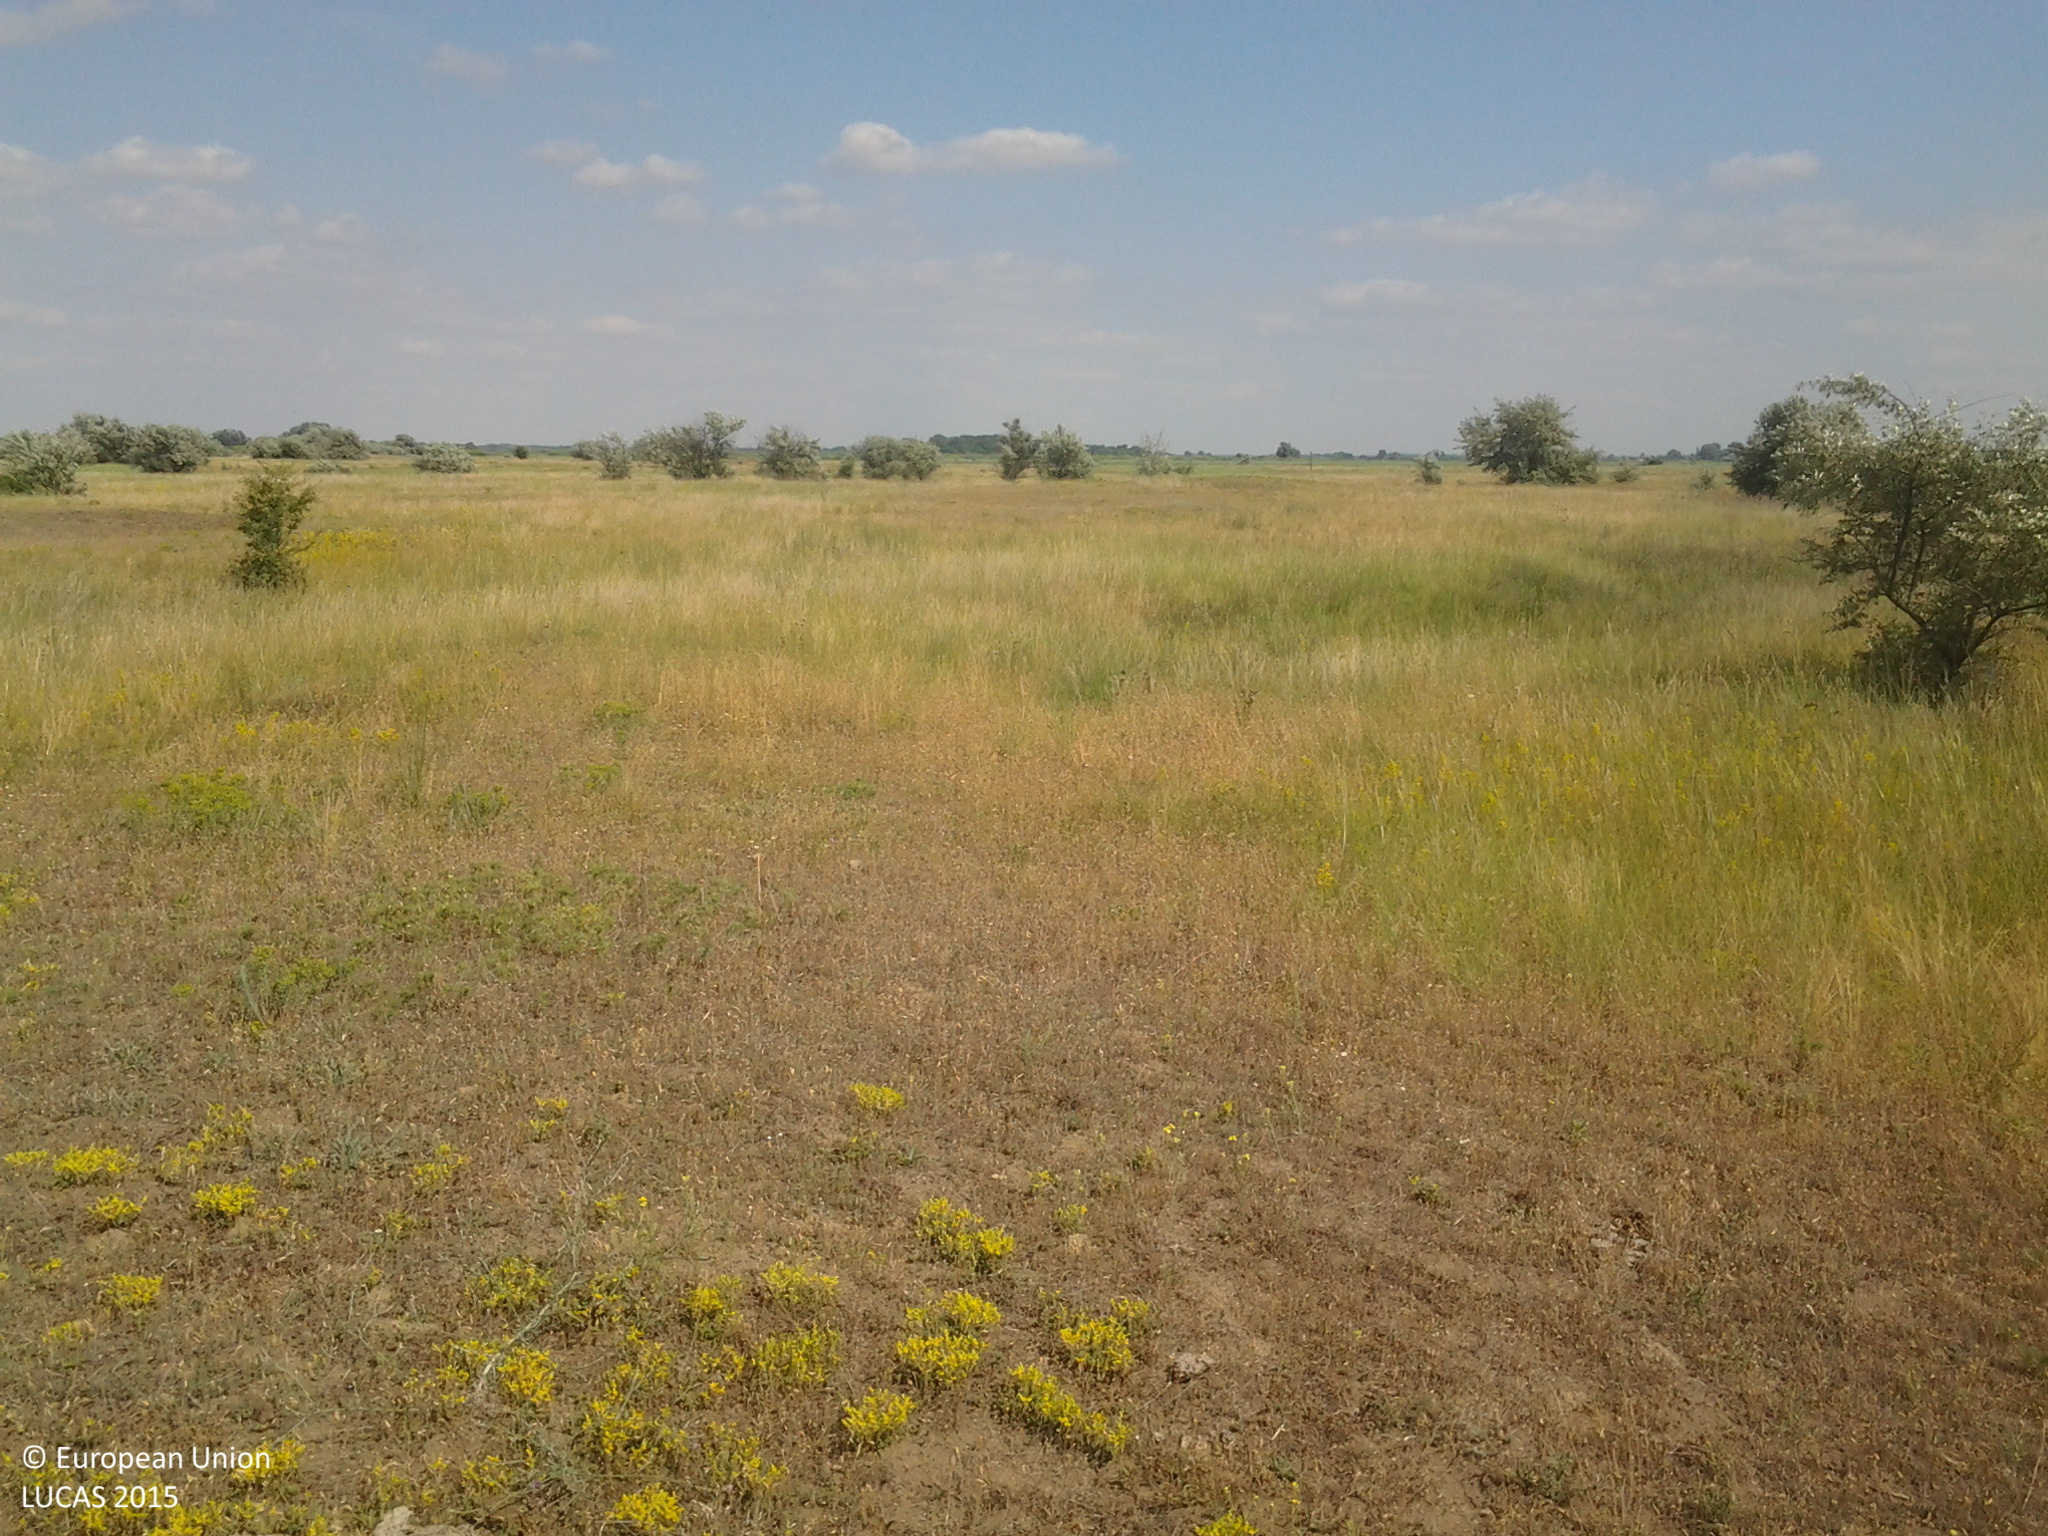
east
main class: Grassland
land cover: Grassland with sparse tree/shrub cover
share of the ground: > 75 %
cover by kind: herbaceous plants 90 %, broadleaved forest trees 5 %, shrubs 5 %
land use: Semi-natural and natural areas not in use
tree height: < 5 m
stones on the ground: < 10 %
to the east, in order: Grassland with sparse tree/shrub cover
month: June
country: HU
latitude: 46.9237
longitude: 19.3023
